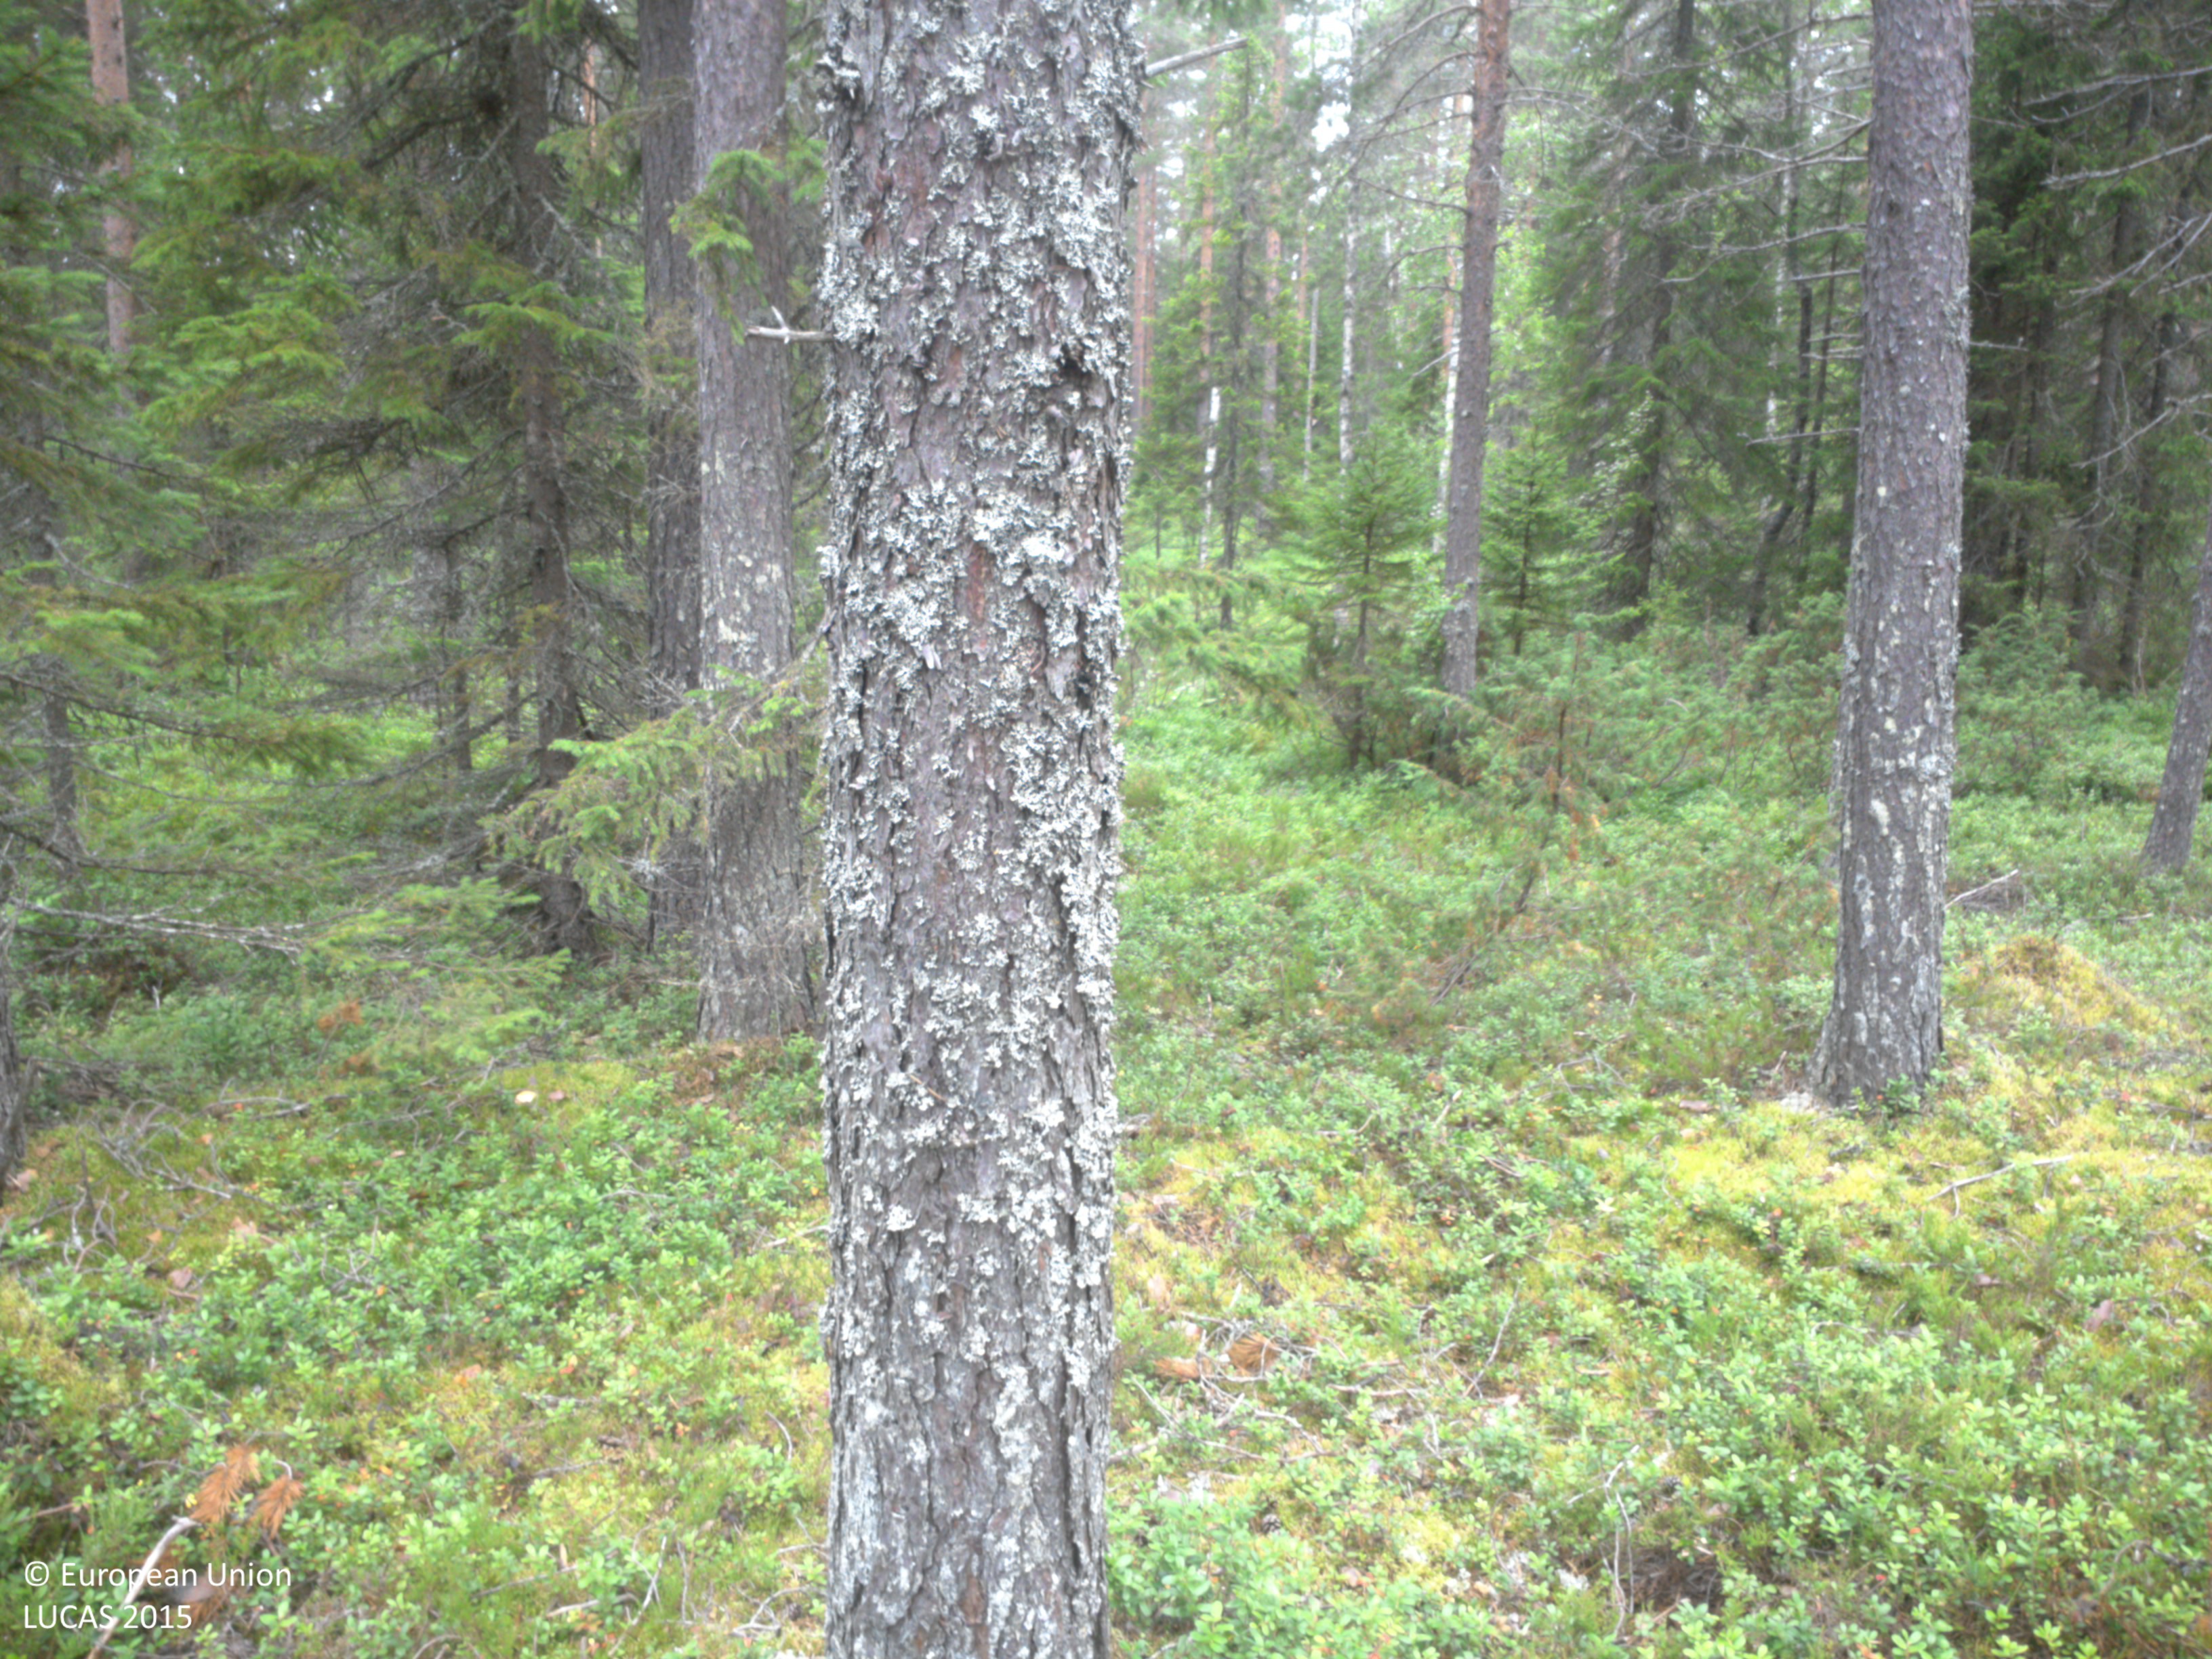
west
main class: Woodland
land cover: Pine dominated coniferous woodland
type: boreal forest
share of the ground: 50 - 75 %
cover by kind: coniferous forest trees 50 %, shrubs 35 %, lichens and mosses 15 %
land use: Forestry
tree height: > 5 m
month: August
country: SE
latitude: 63.7276
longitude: 19.8413
